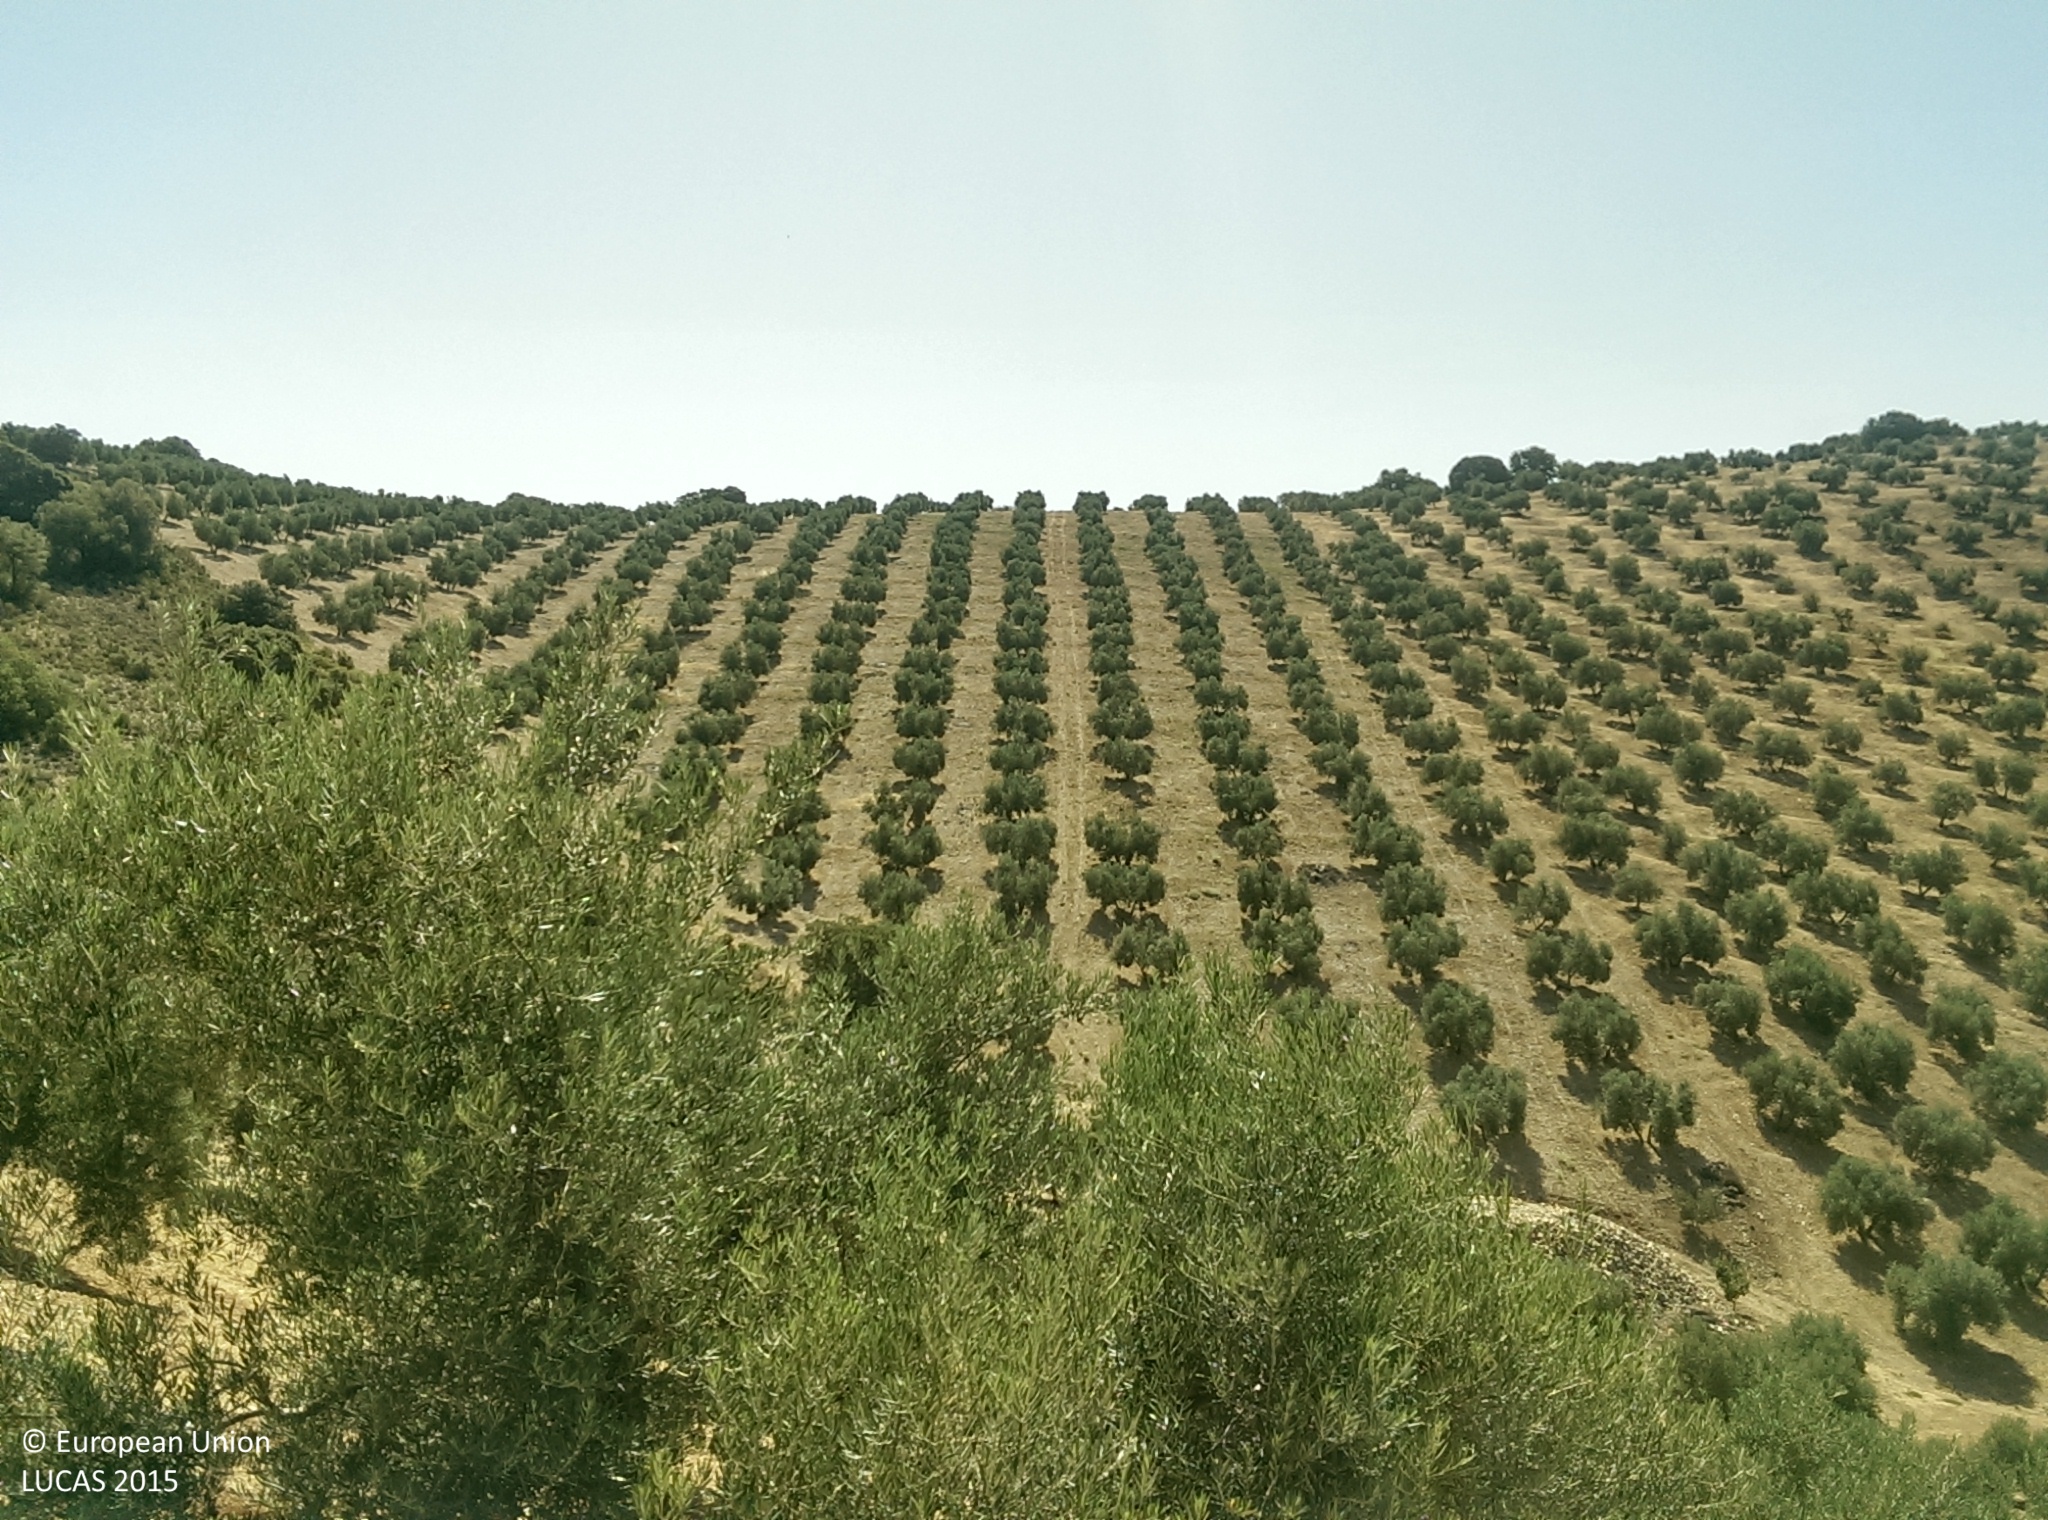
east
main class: Cropland
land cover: Olive groves
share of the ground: 25 - 50 %
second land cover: Spontaneously vegetated surfaces
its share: 25 - 50 %
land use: Agriculture (excluding fallow land and kitchen gardens)
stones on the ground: 10 - 25 %
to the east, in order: Olive groves; Spontaneously vegetated surfaces; Other structural elements; Grassland with sparse tree/shrub cover; Olive groves
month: July
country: ES
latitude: 37.4592
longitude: -3.7539
